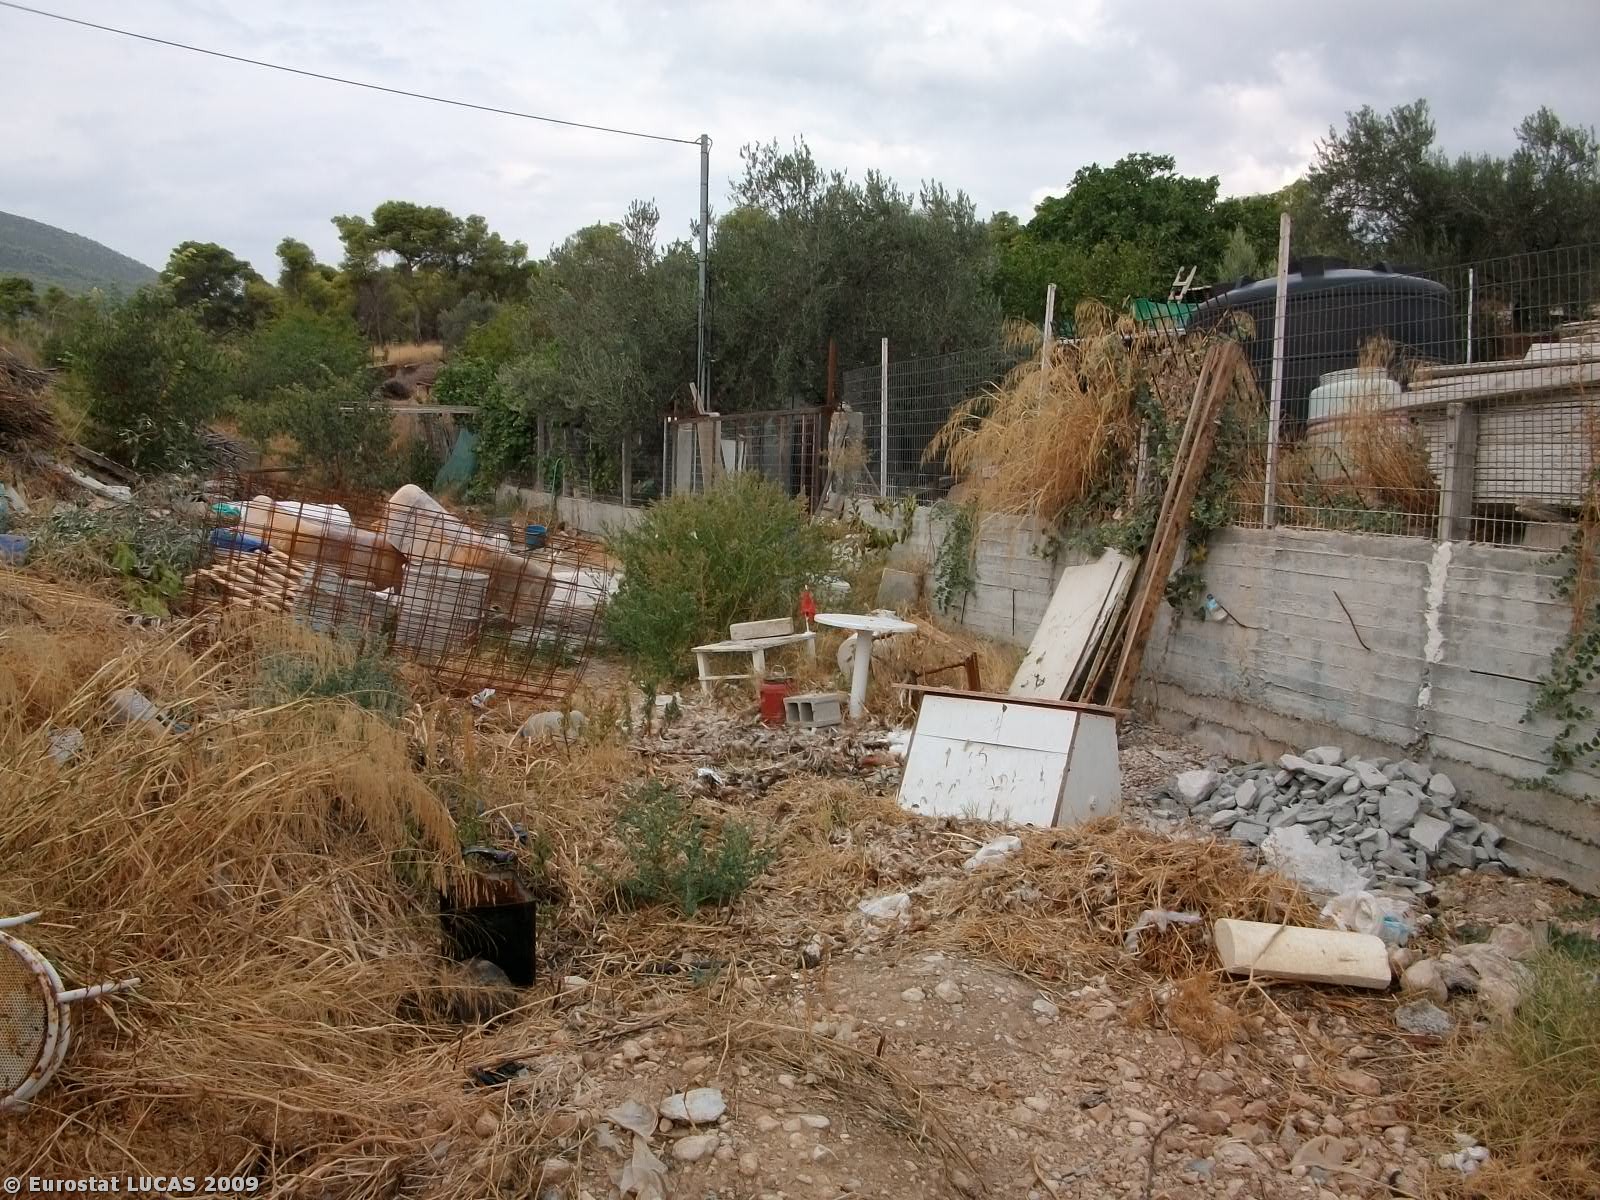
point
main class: Grassland
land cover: Grassland without tree/shrub cover
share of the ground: > 75 %
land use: Unused
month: September
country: GR
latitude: 37.8438
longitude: 22.9829
